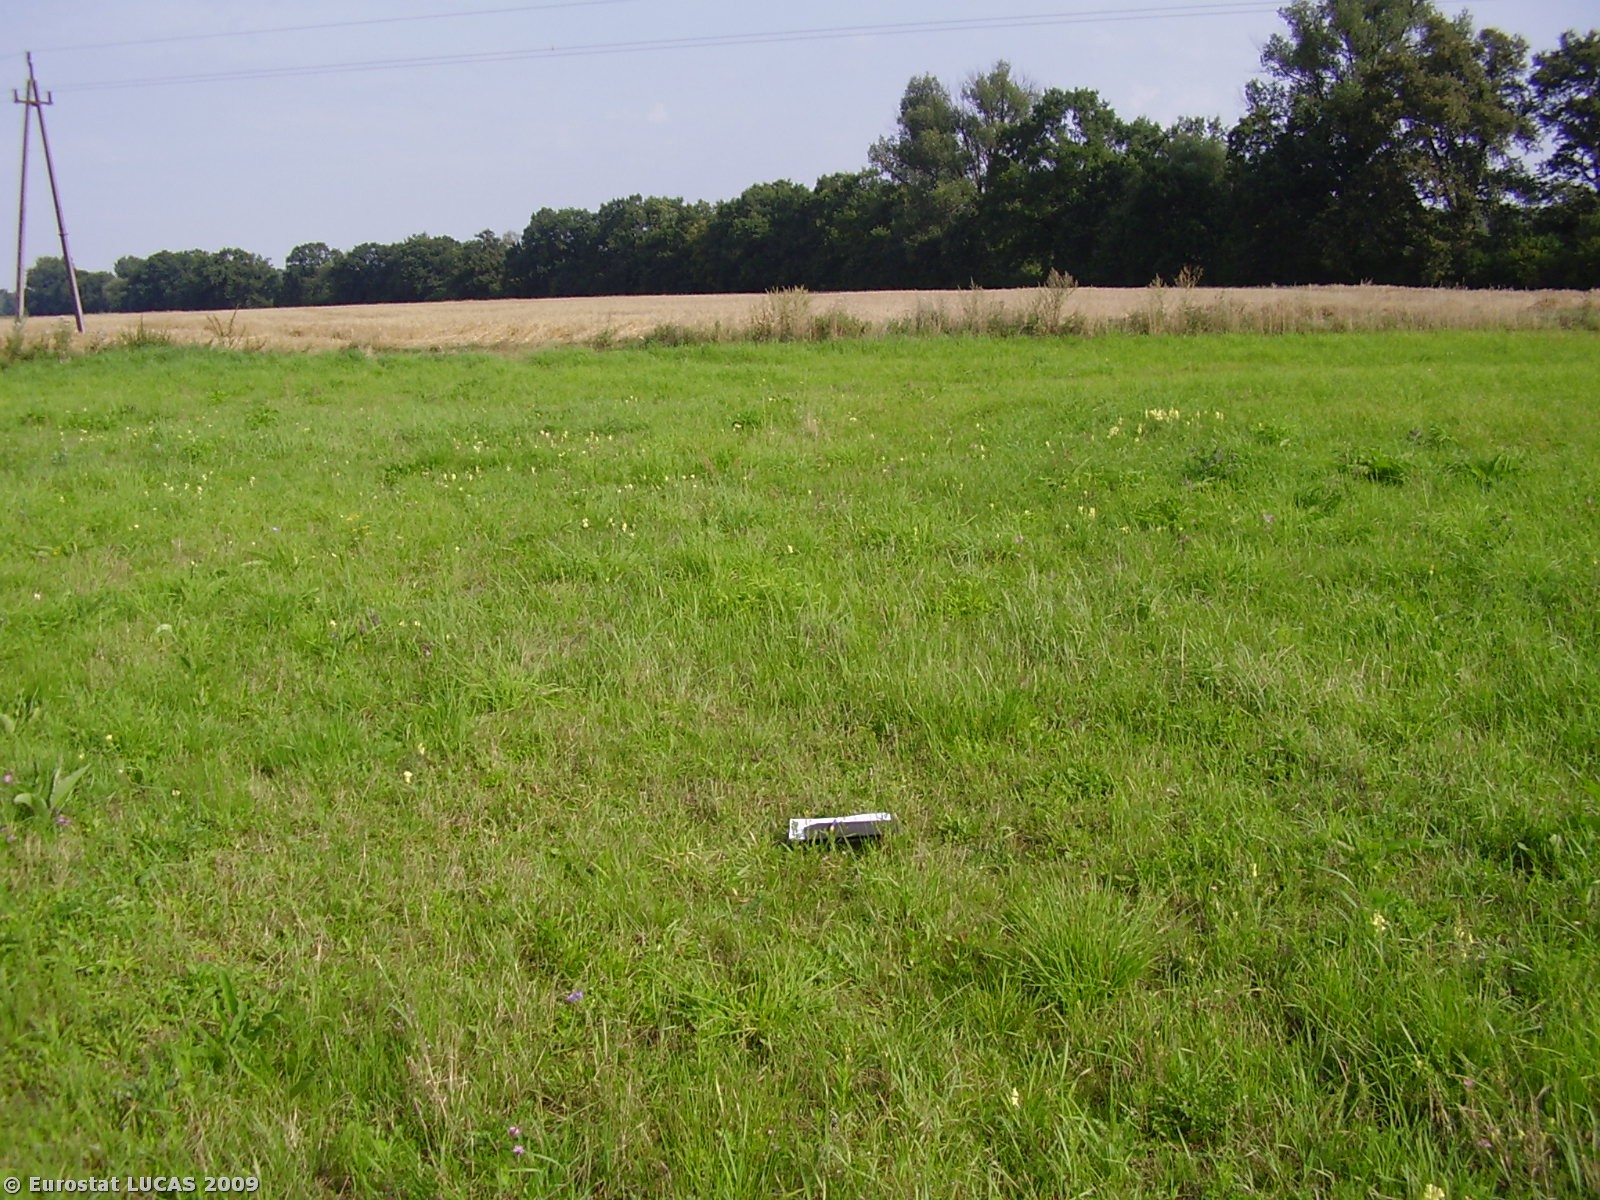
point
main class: Grassland
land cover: Grassland without tree/shrub cover
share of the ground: > 75 %
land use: Agriculture (excluding fallow land and kitchen gardens)
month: August
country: PL
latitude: 51.6591
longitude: 16.1502
